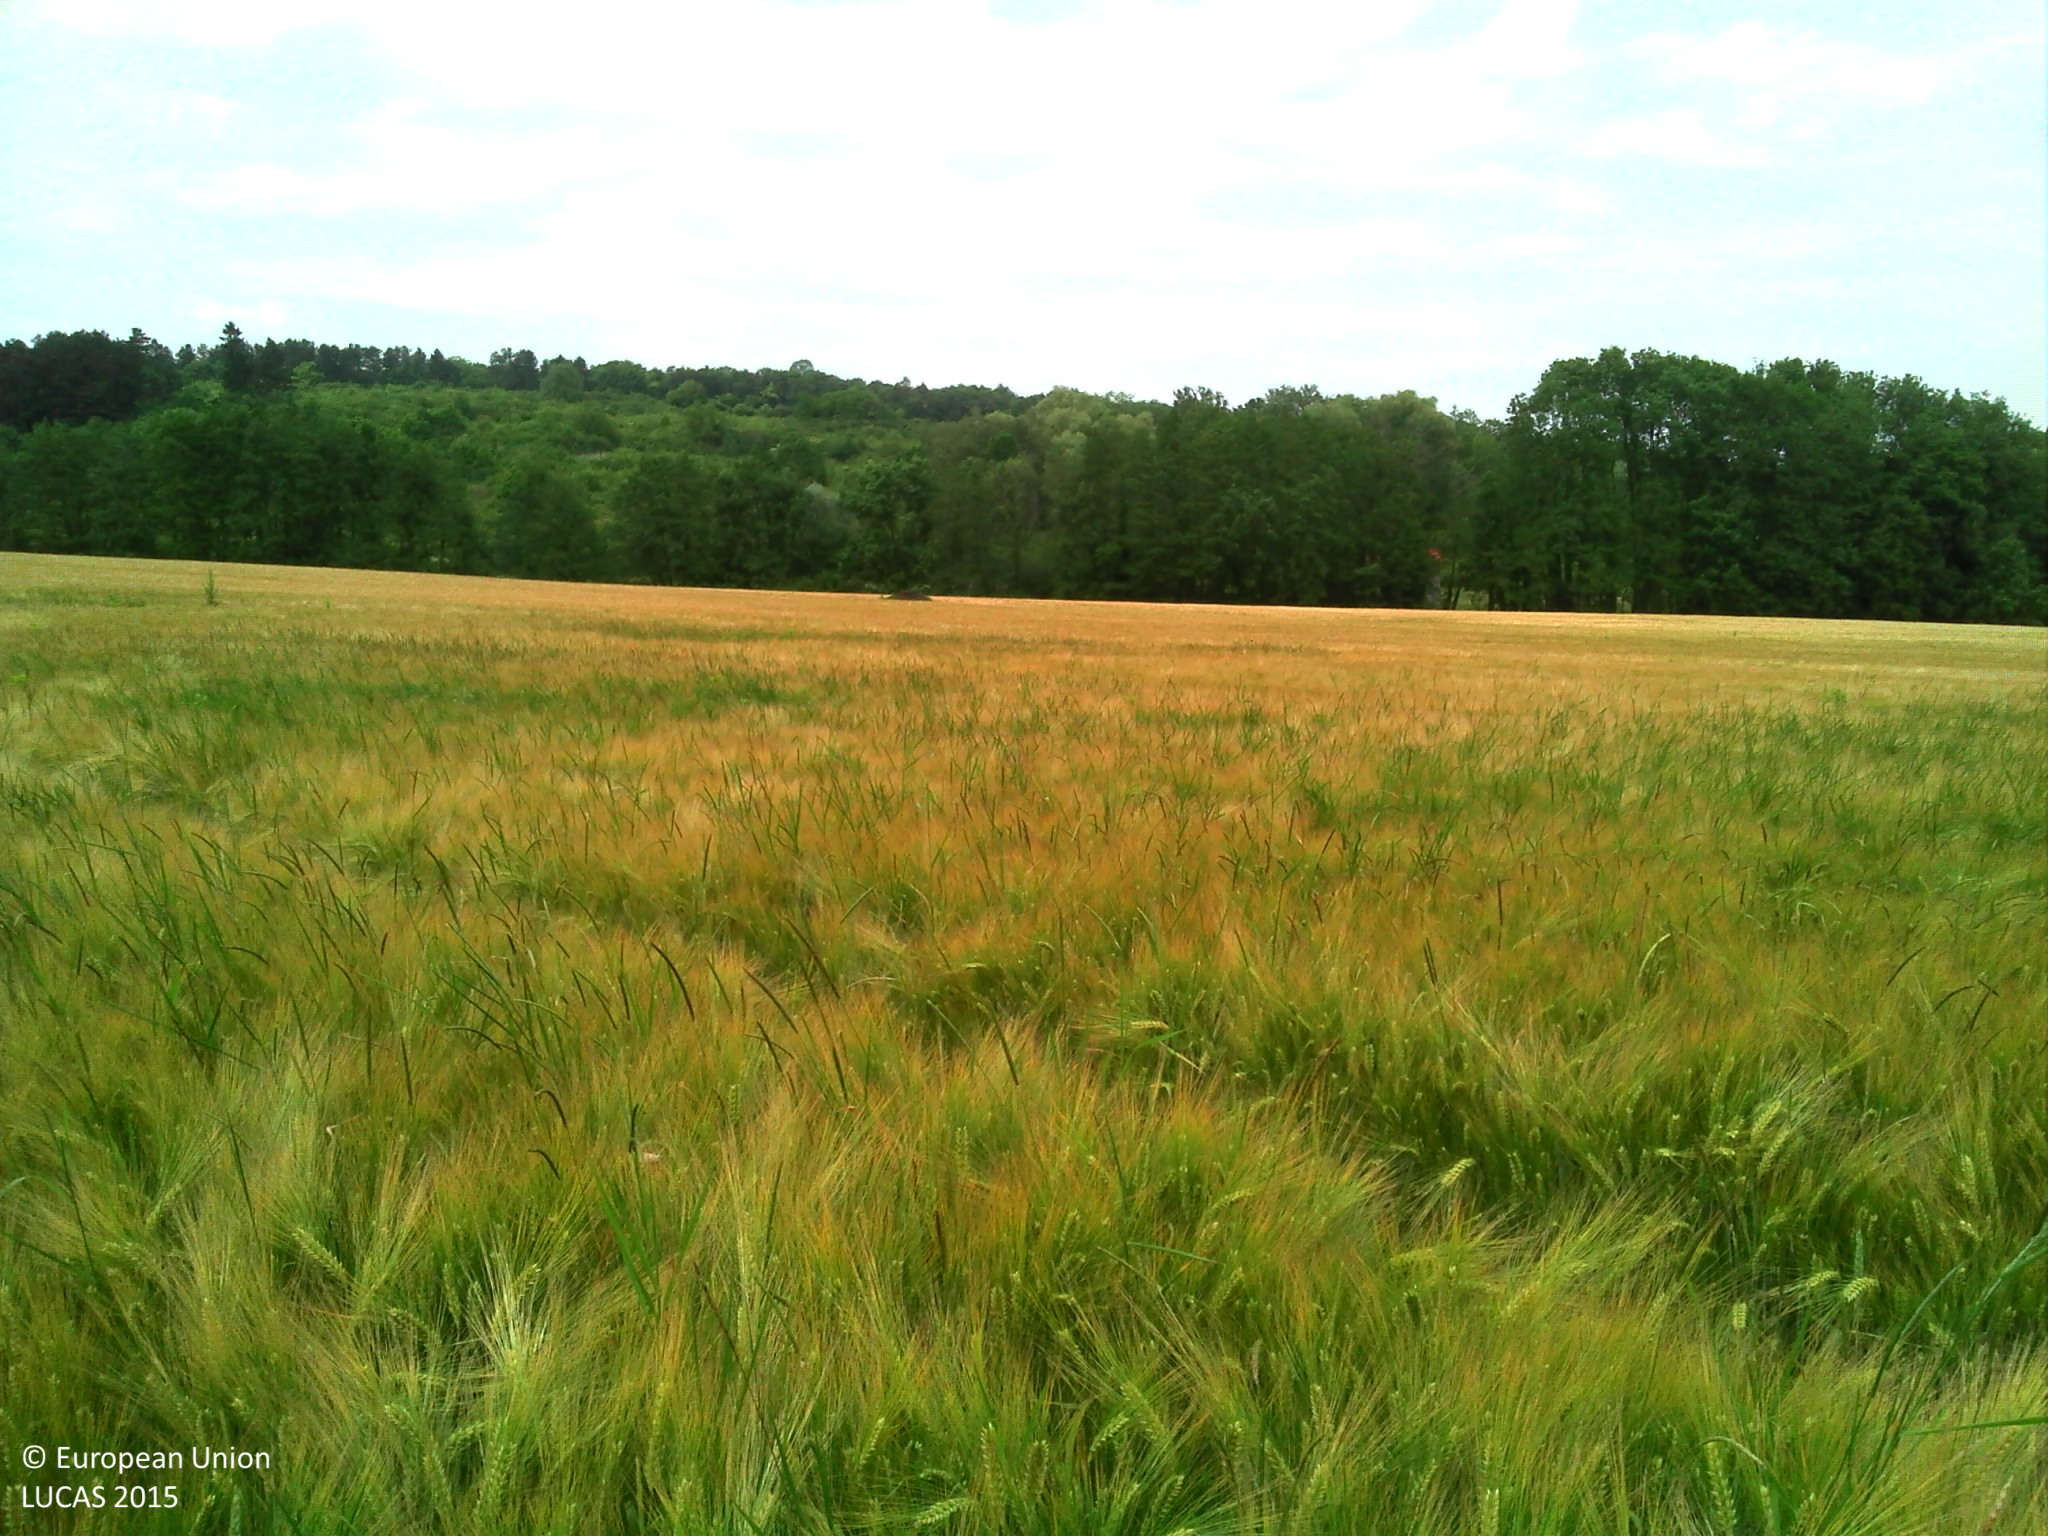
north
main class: Cropland
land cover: Barley
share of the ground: > 75 %
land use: Agriculture (excluding fallow land and kitchen gardens)
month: June
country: FR
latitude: 48.5200
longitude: 6.2499
